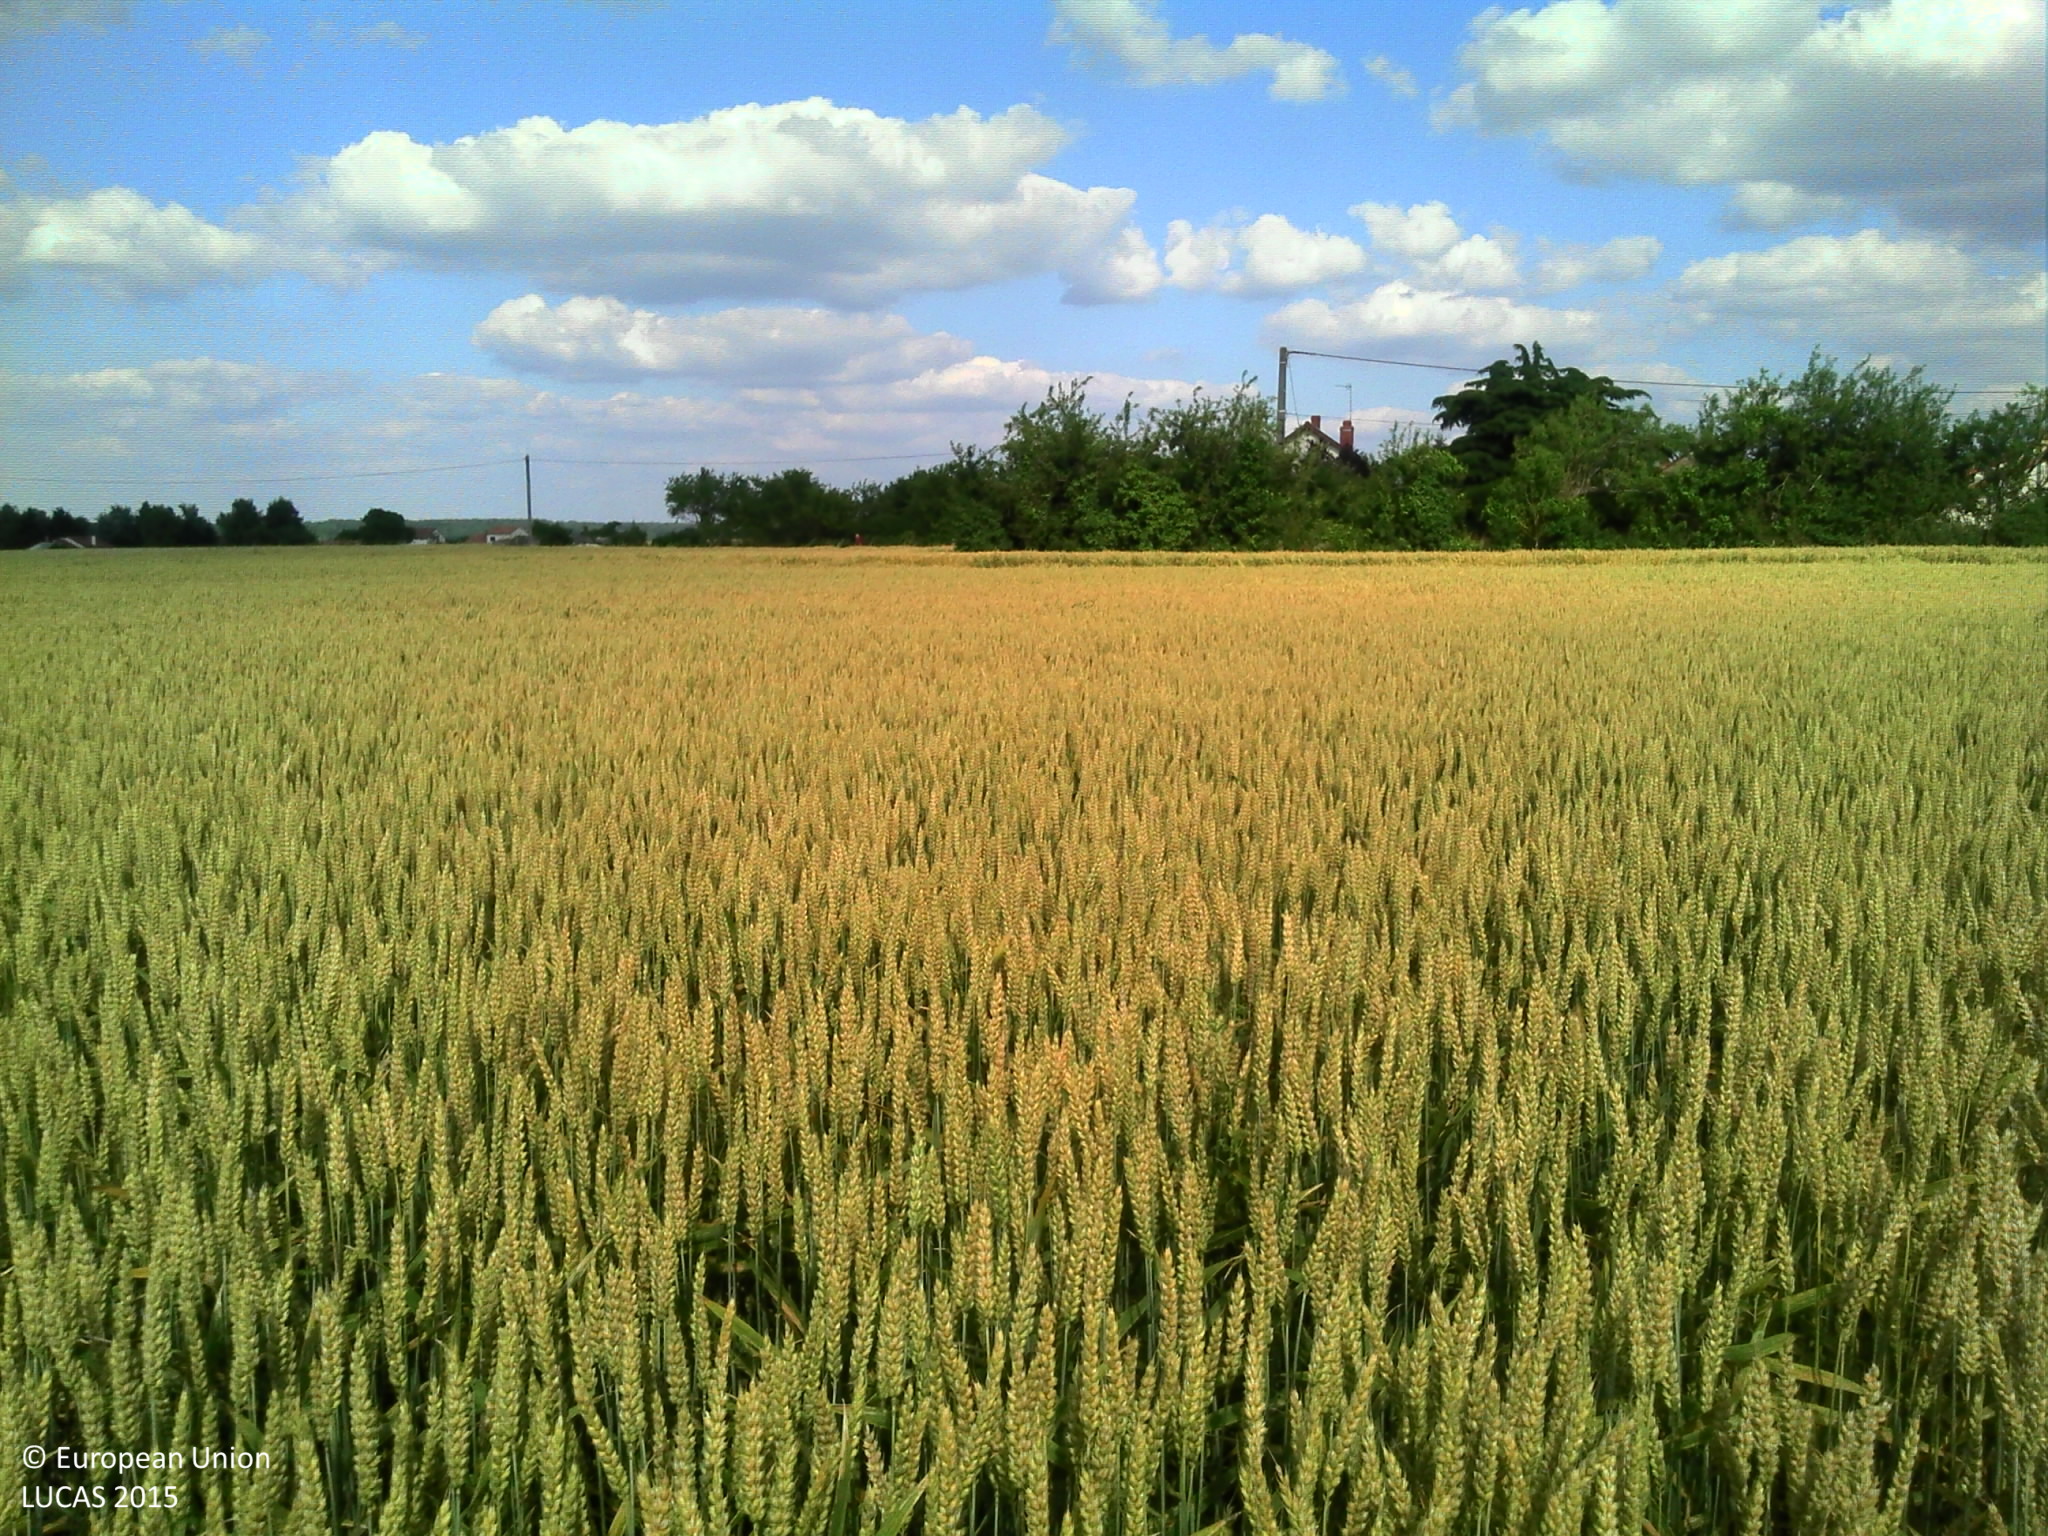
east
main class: Cropland
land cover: Common wheat
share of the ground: > 75 %
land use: Agriculture (excluding fallow land and kitchen gardens)
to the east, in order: Common wheat; Managed hedges; Common wheat; Electric lines; Grass margins; Paved roads, cycling and walking lanes; Grass margins; Artificial constructions in urban areas; Common wheat
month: June
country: FR
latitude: 46.7495
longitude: 0.5703
